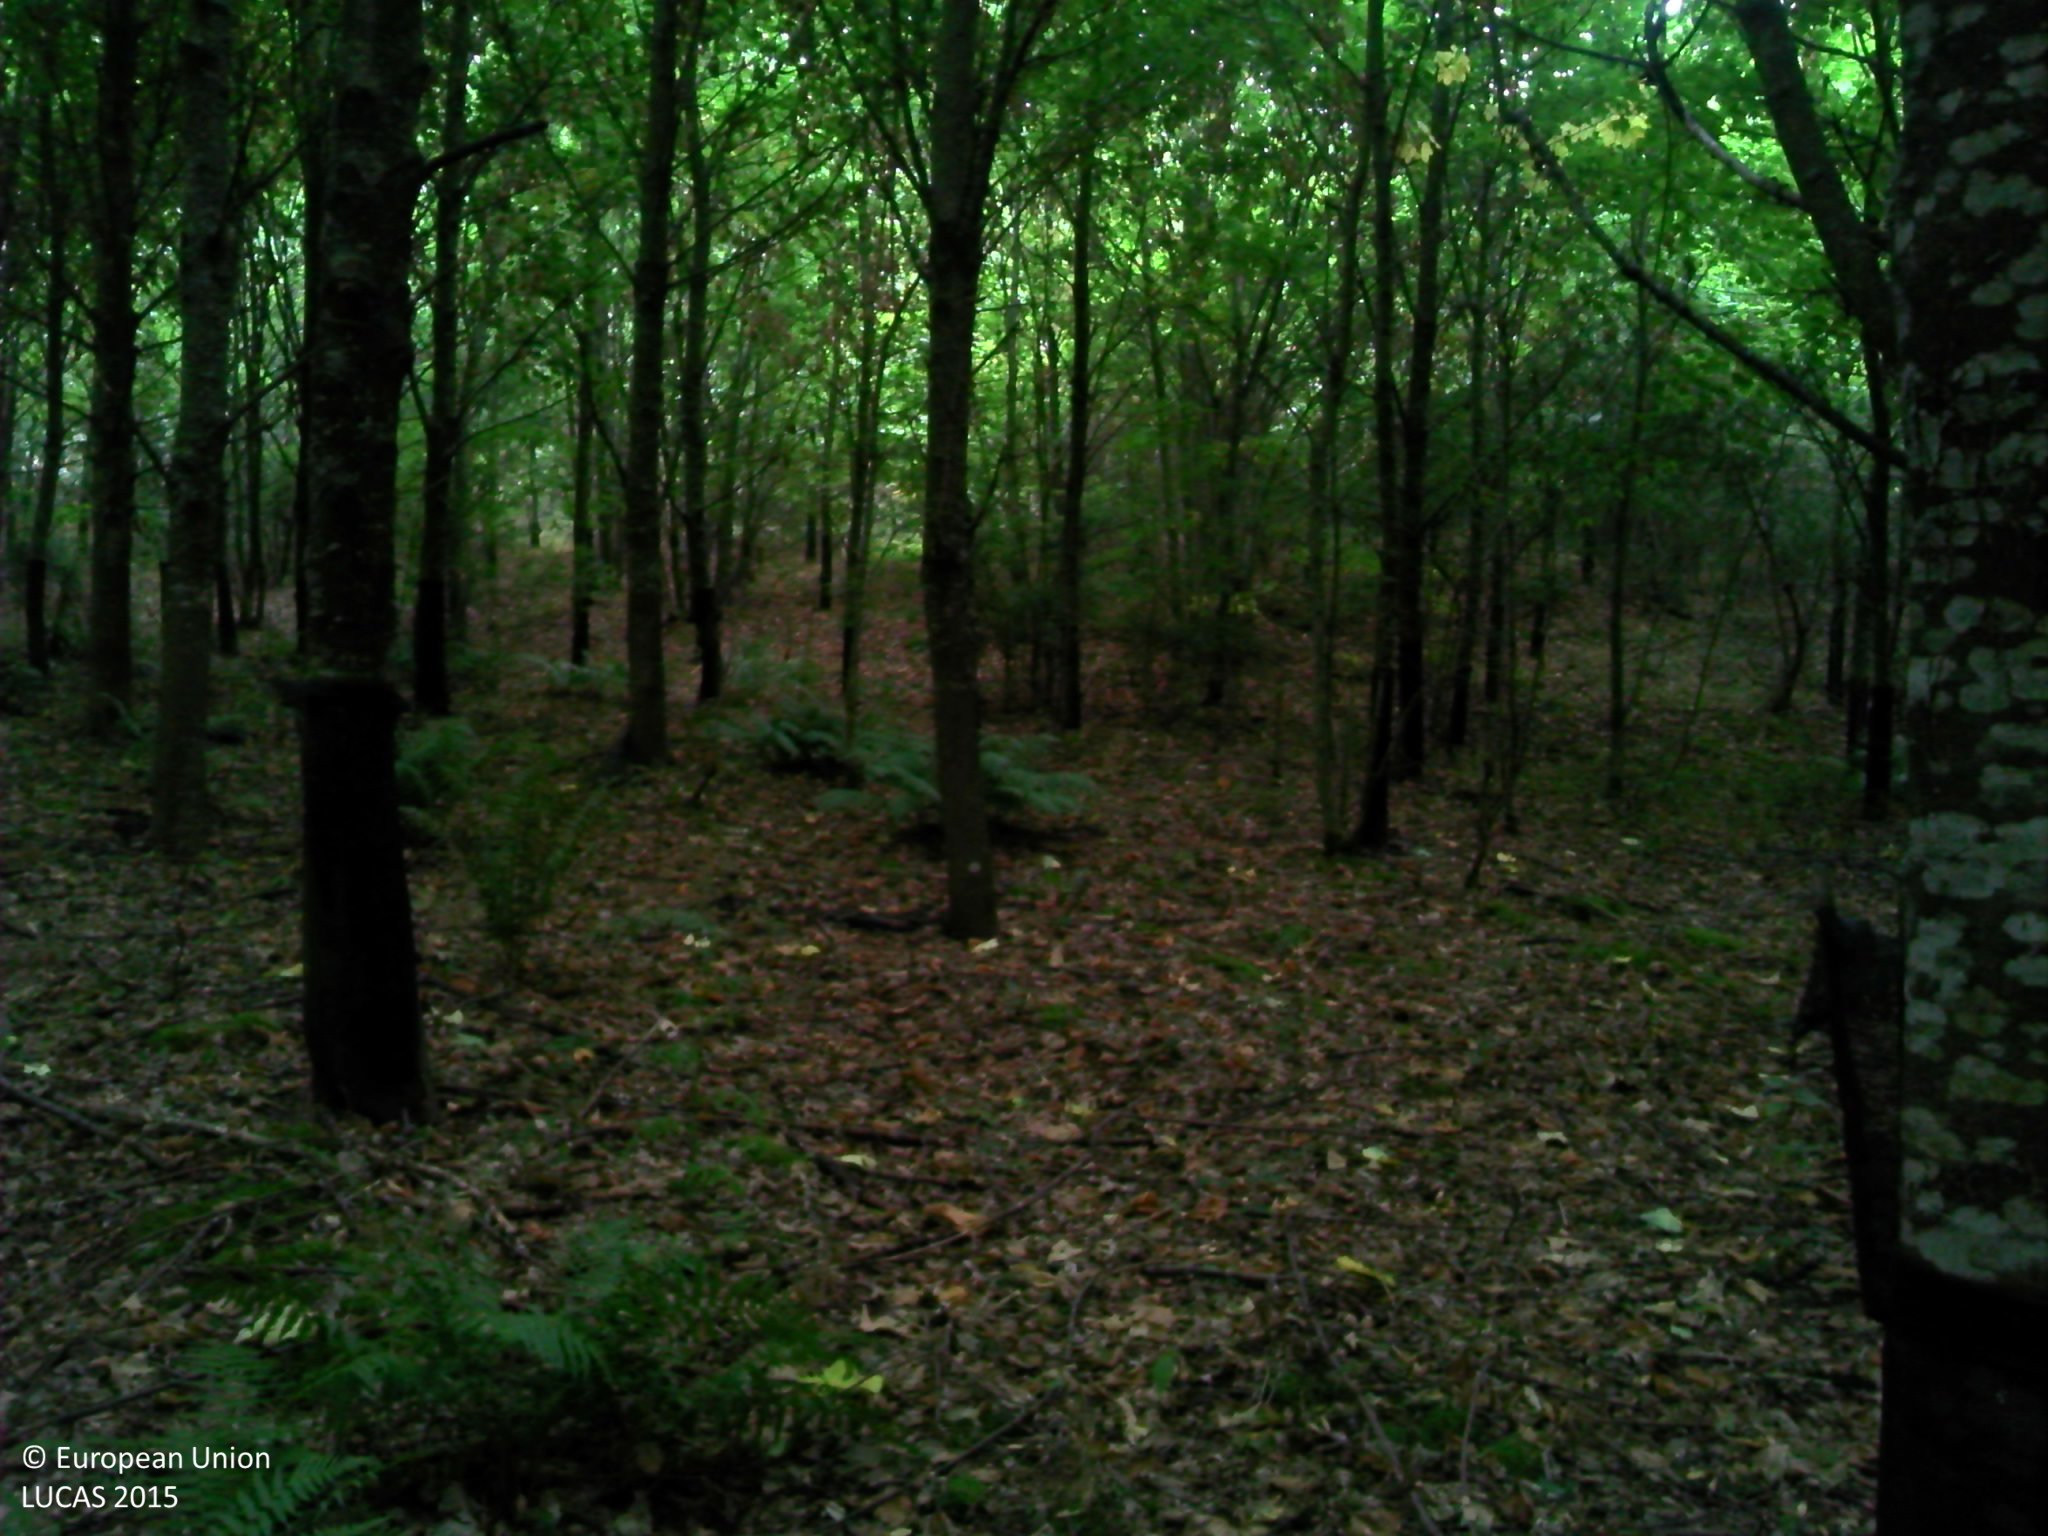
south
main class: Woodland
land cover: Broadleaved woodland
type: exotic forest
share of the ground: > 75 %
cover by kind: broadleaved forest trees 90 %, herbaceous plants 5 %
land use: Forestry
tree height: > 5 m
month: August
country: FR
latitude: 44.9119
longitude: 4.5462
